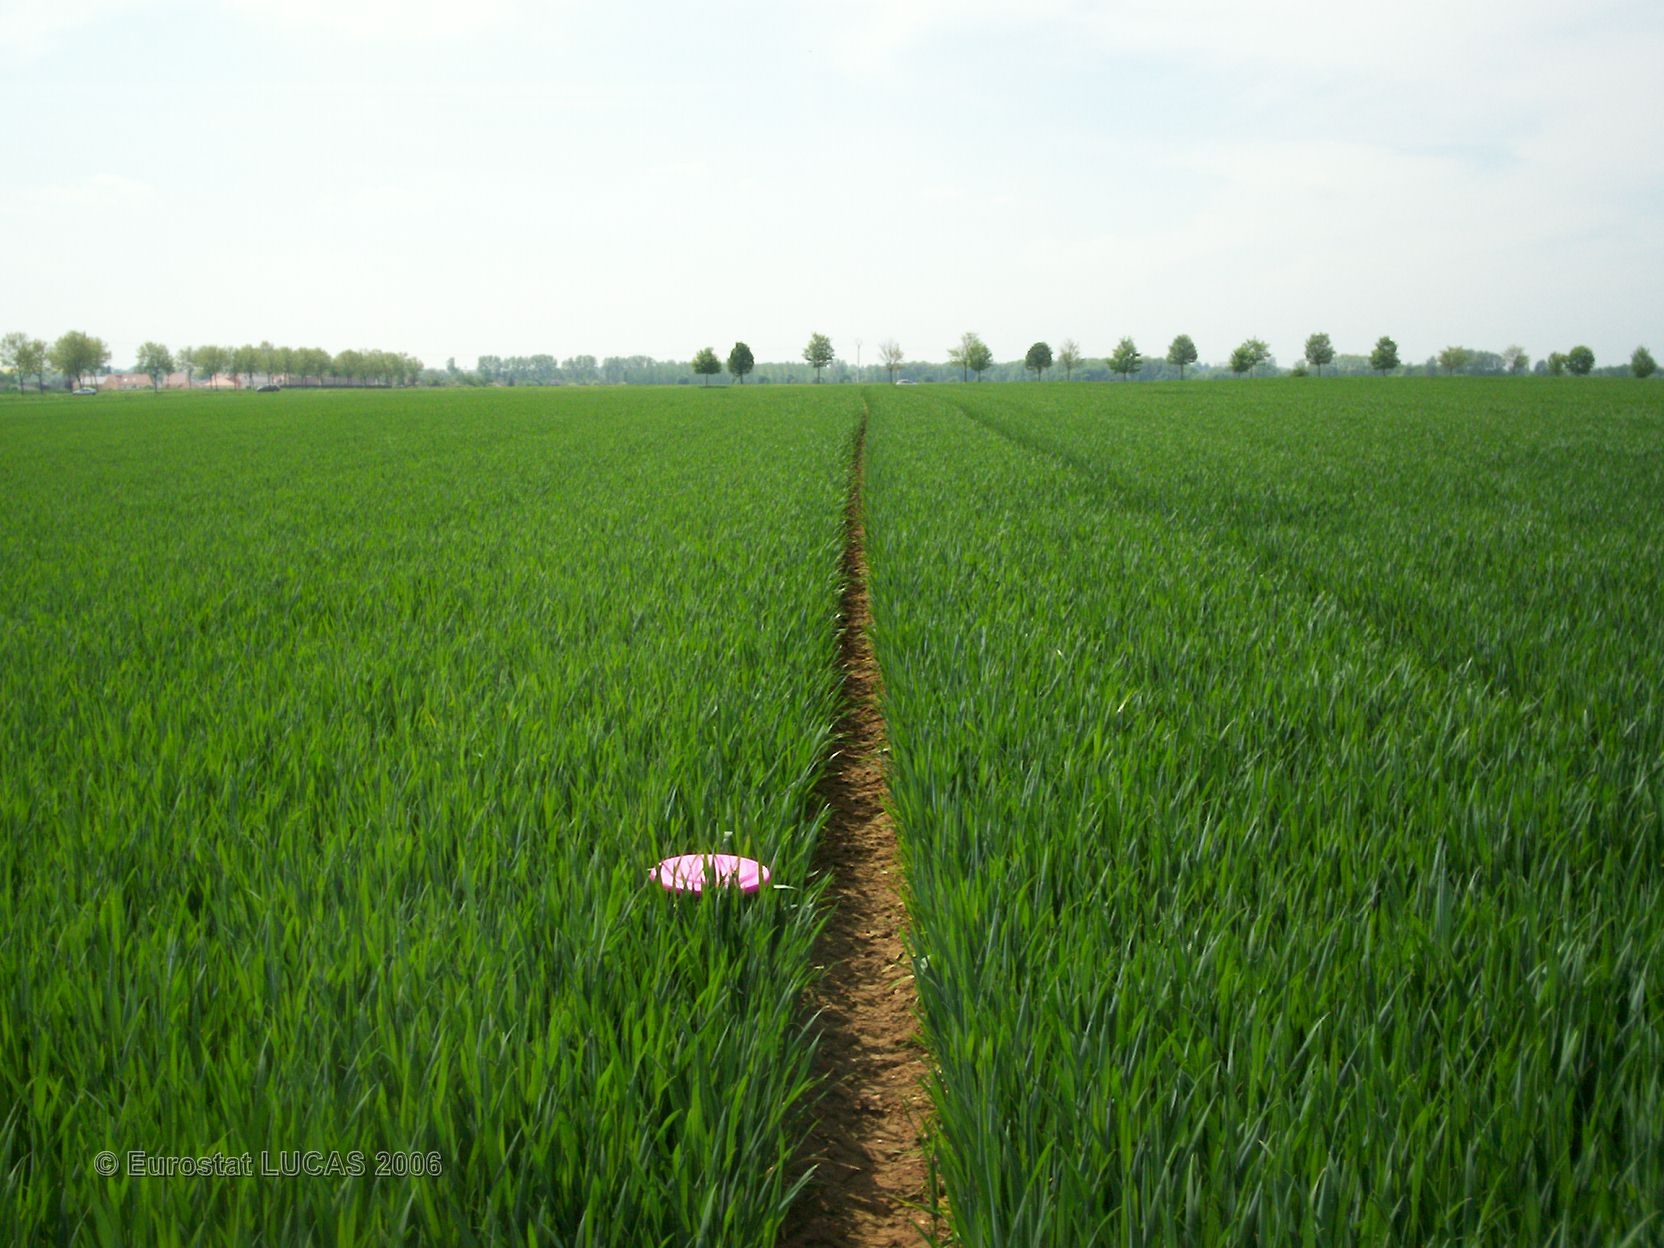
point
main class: Cropland
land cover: Common wheat
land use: Agriculture (excluding fallow land and kitchen gardens)
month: May
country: FR
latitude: 48.9296
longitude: 4.4138
